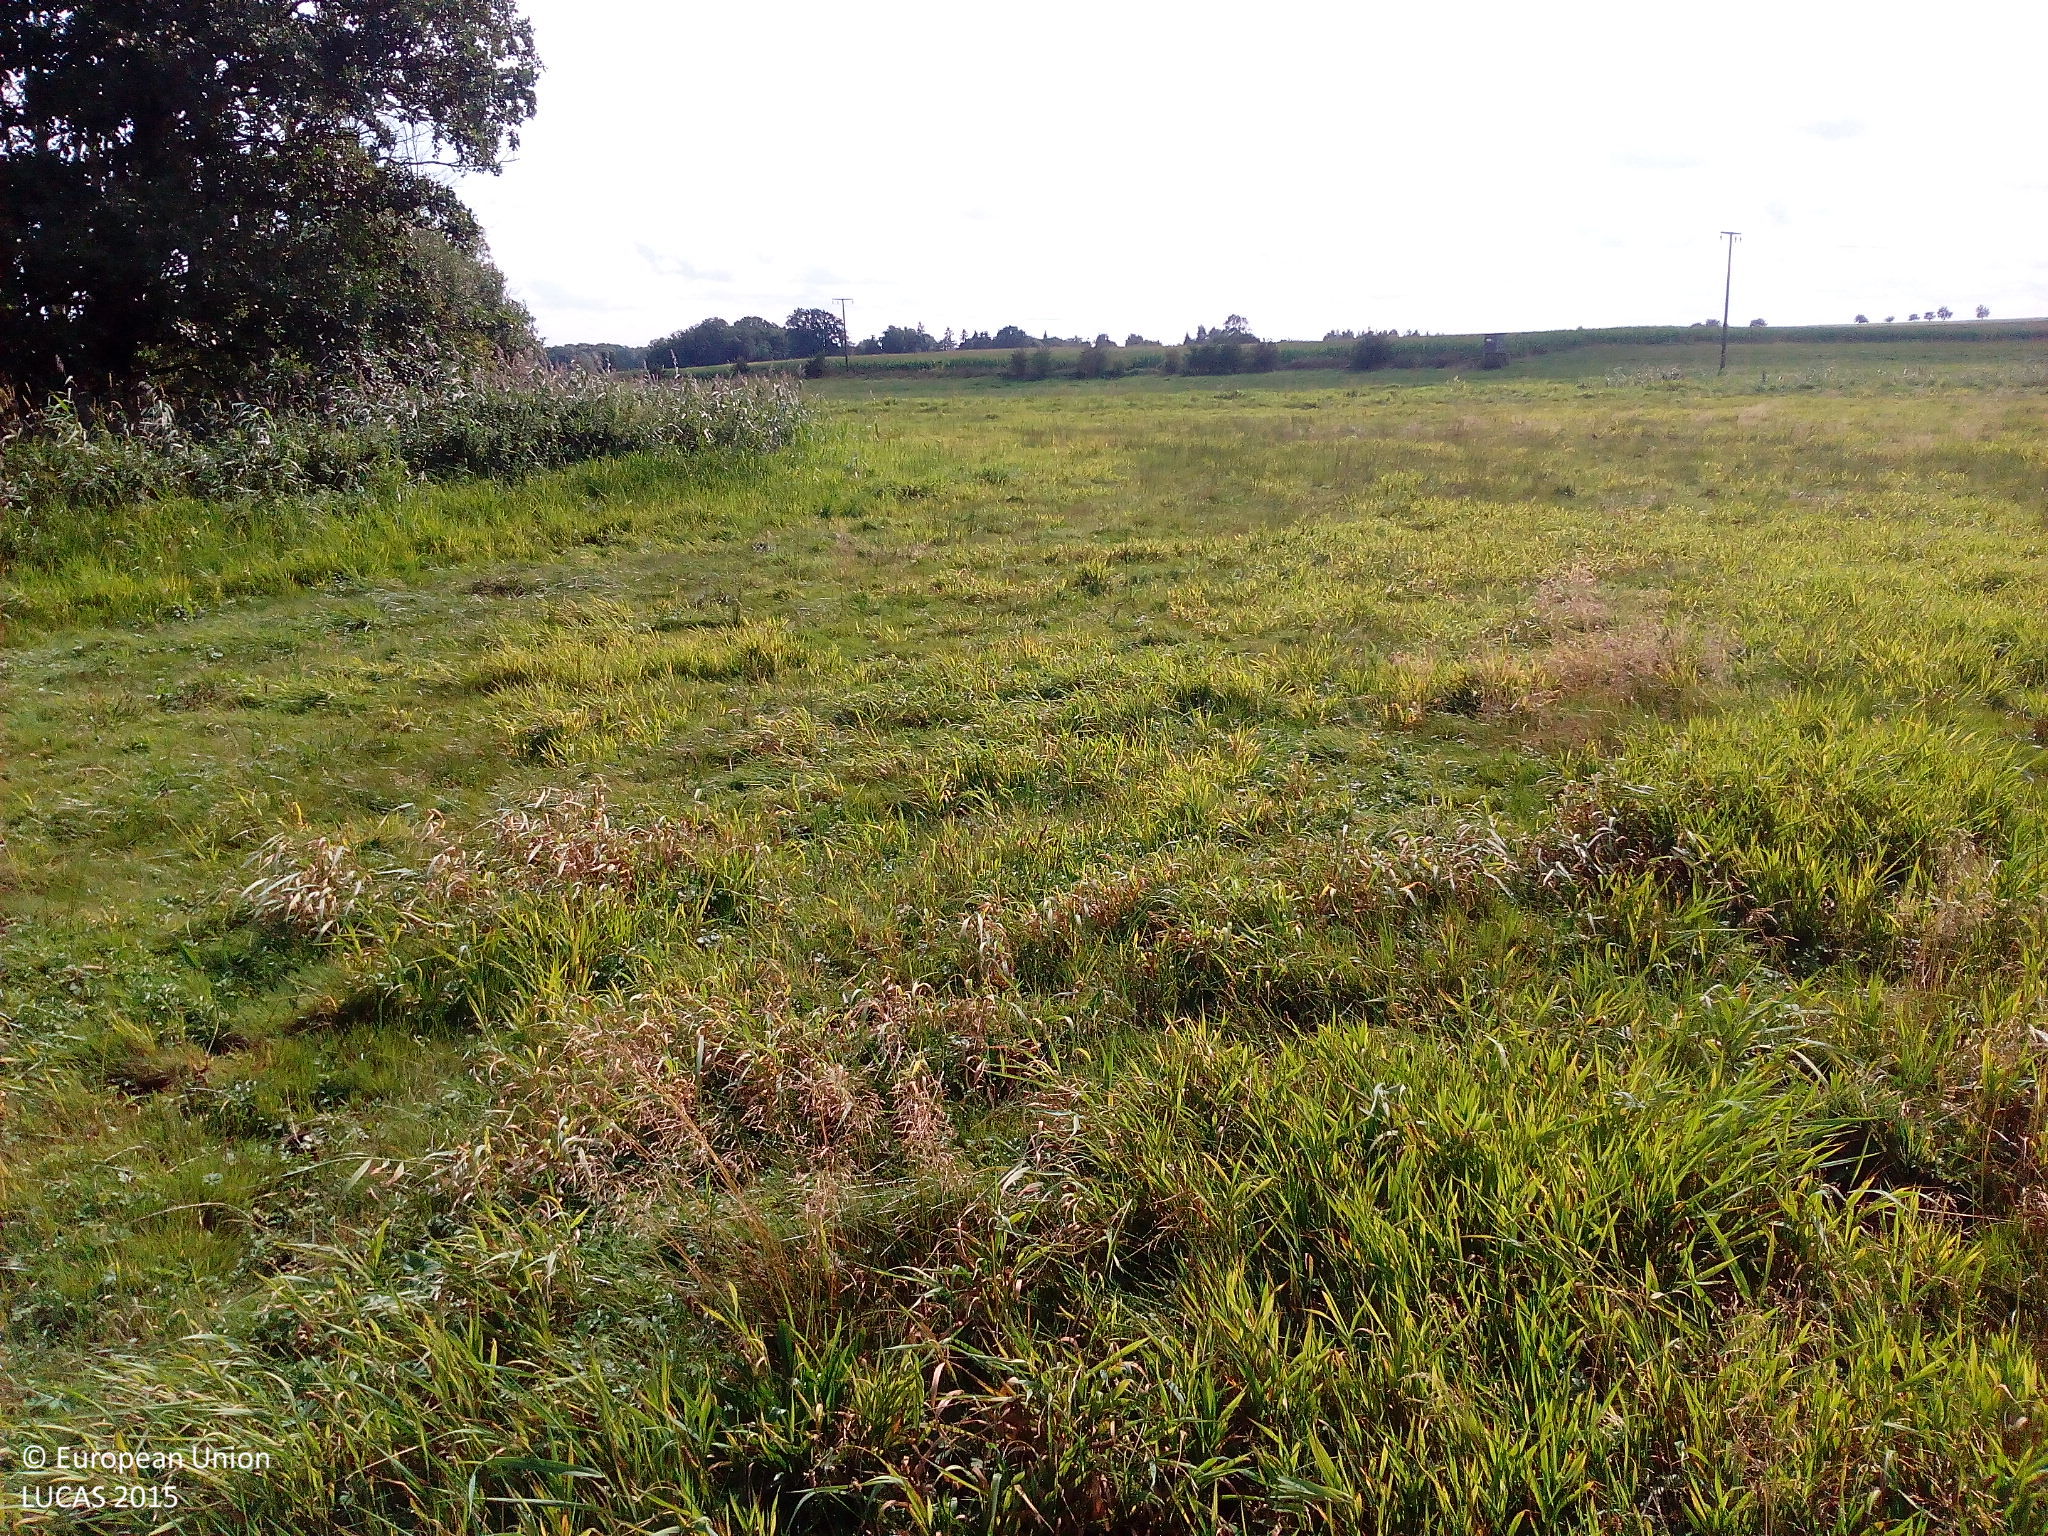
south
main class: Grassland
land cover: Grassland without tree/shrub cover
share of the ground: > 75 %
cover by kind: herbaceous plants 100 %
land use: Agriculture (excluding fallow land and kitchen gardens)
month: August
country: DE
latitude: 53.9295
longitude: 12.6949
